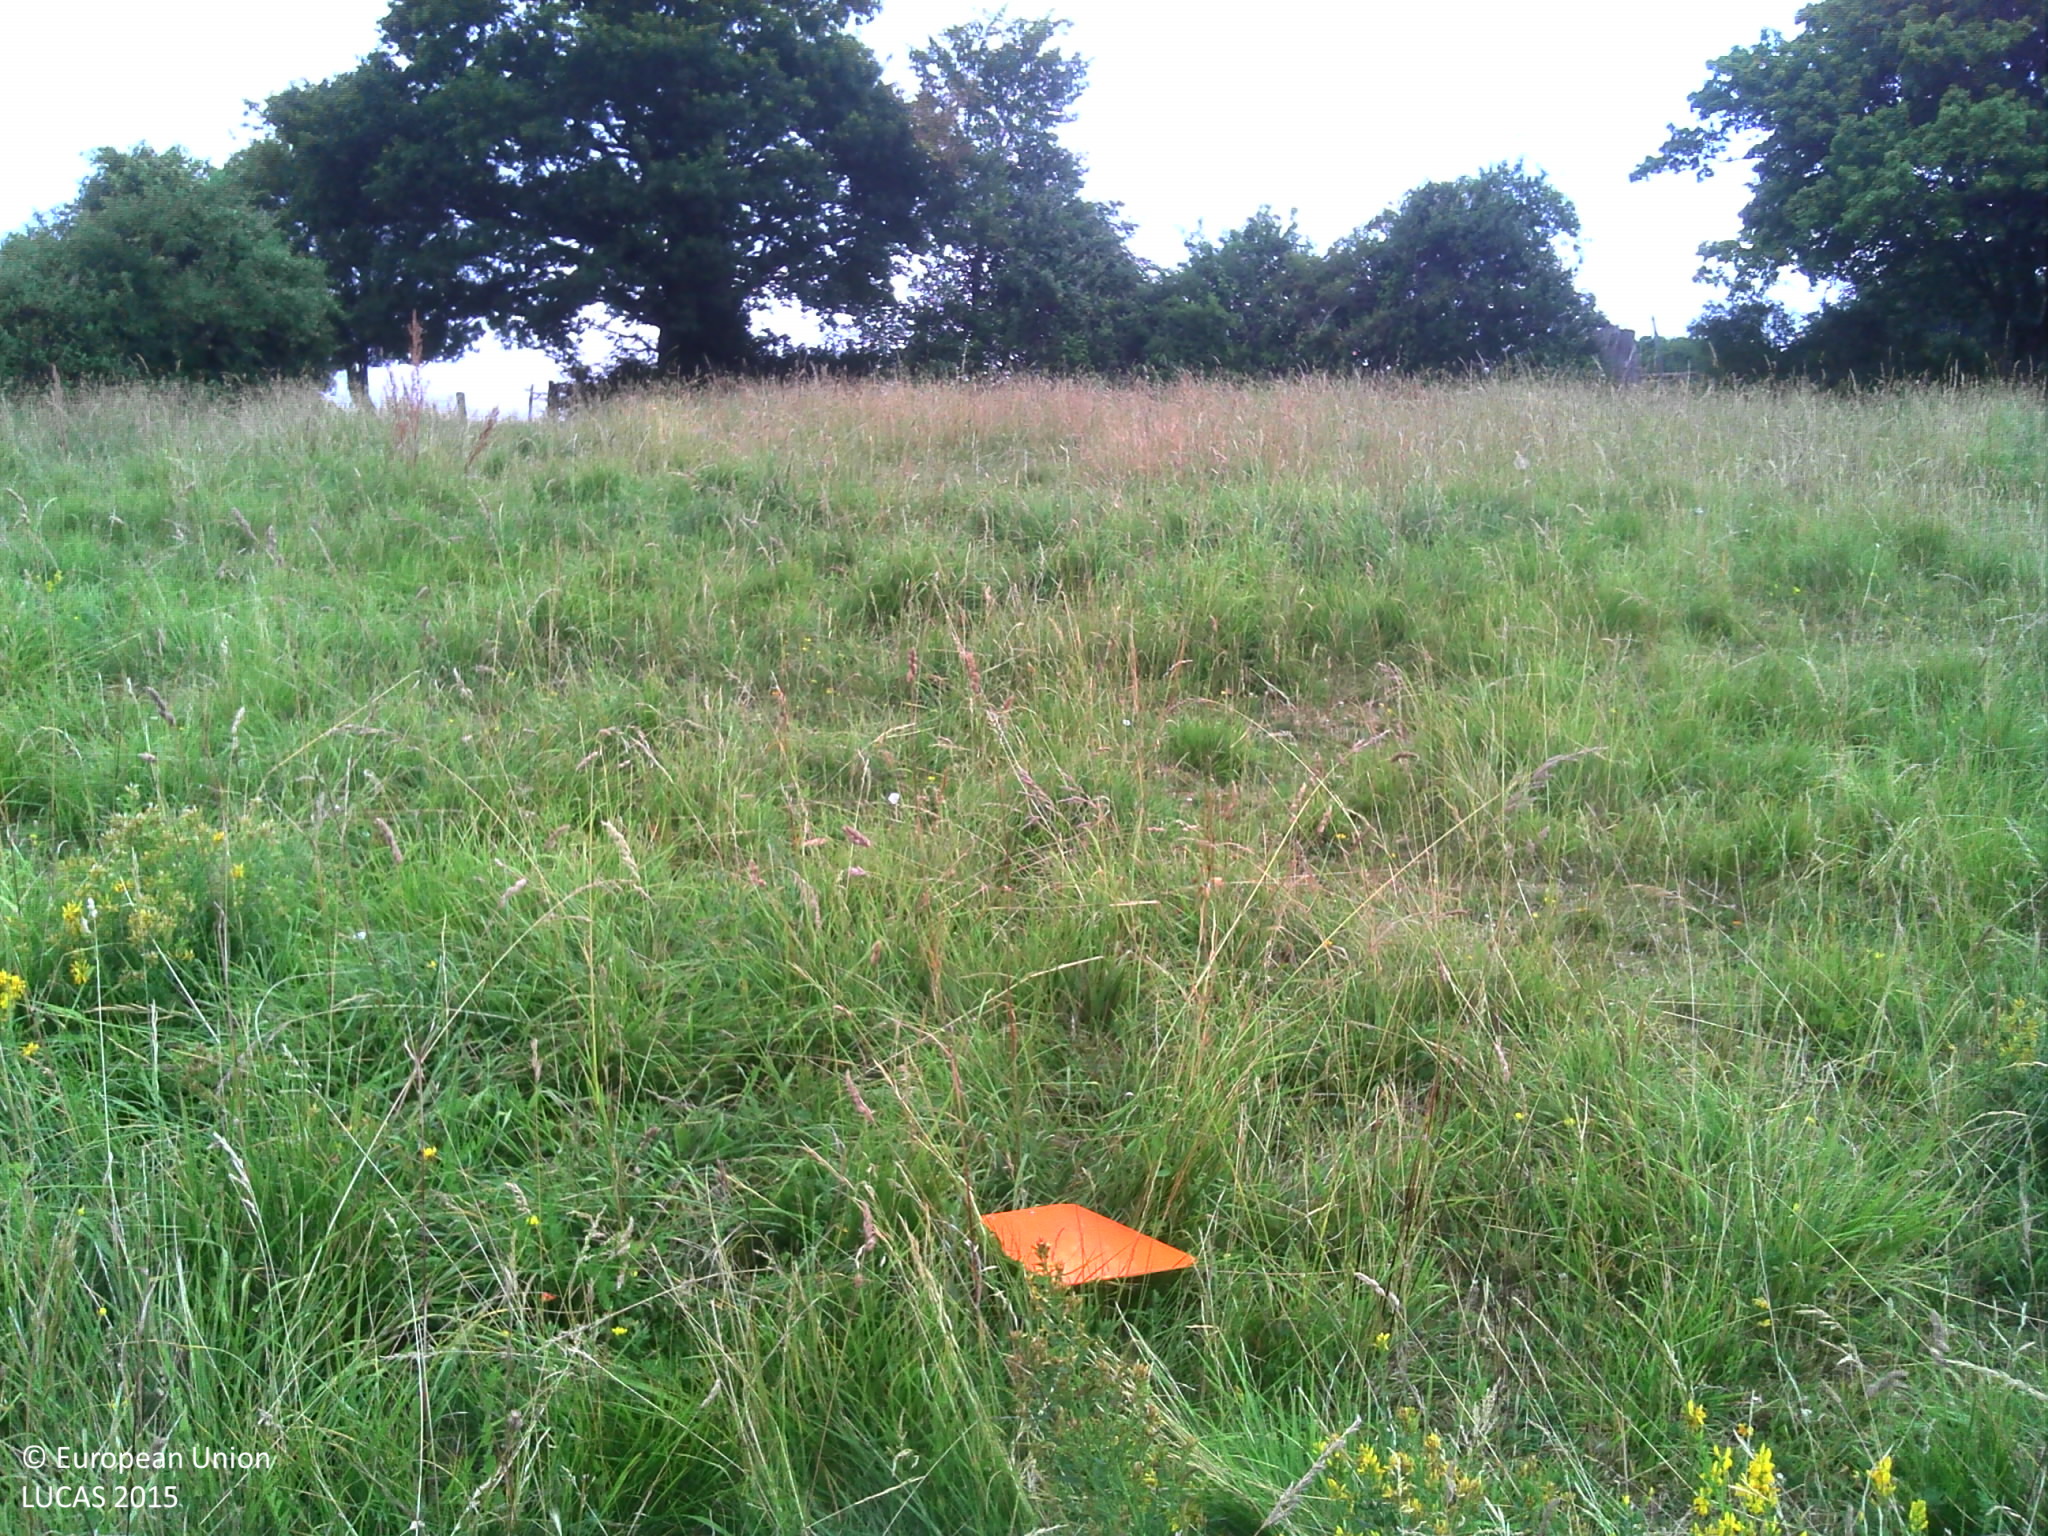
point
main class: Grassland
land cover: Grassland without tree/shrub cover
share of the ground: > 75 %
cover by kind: herbaceous plants 100 %
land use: Agriculture (excluding fallow land and kitchen gardens)
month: July
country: FR
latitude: 49.0033
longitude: 0.0317
